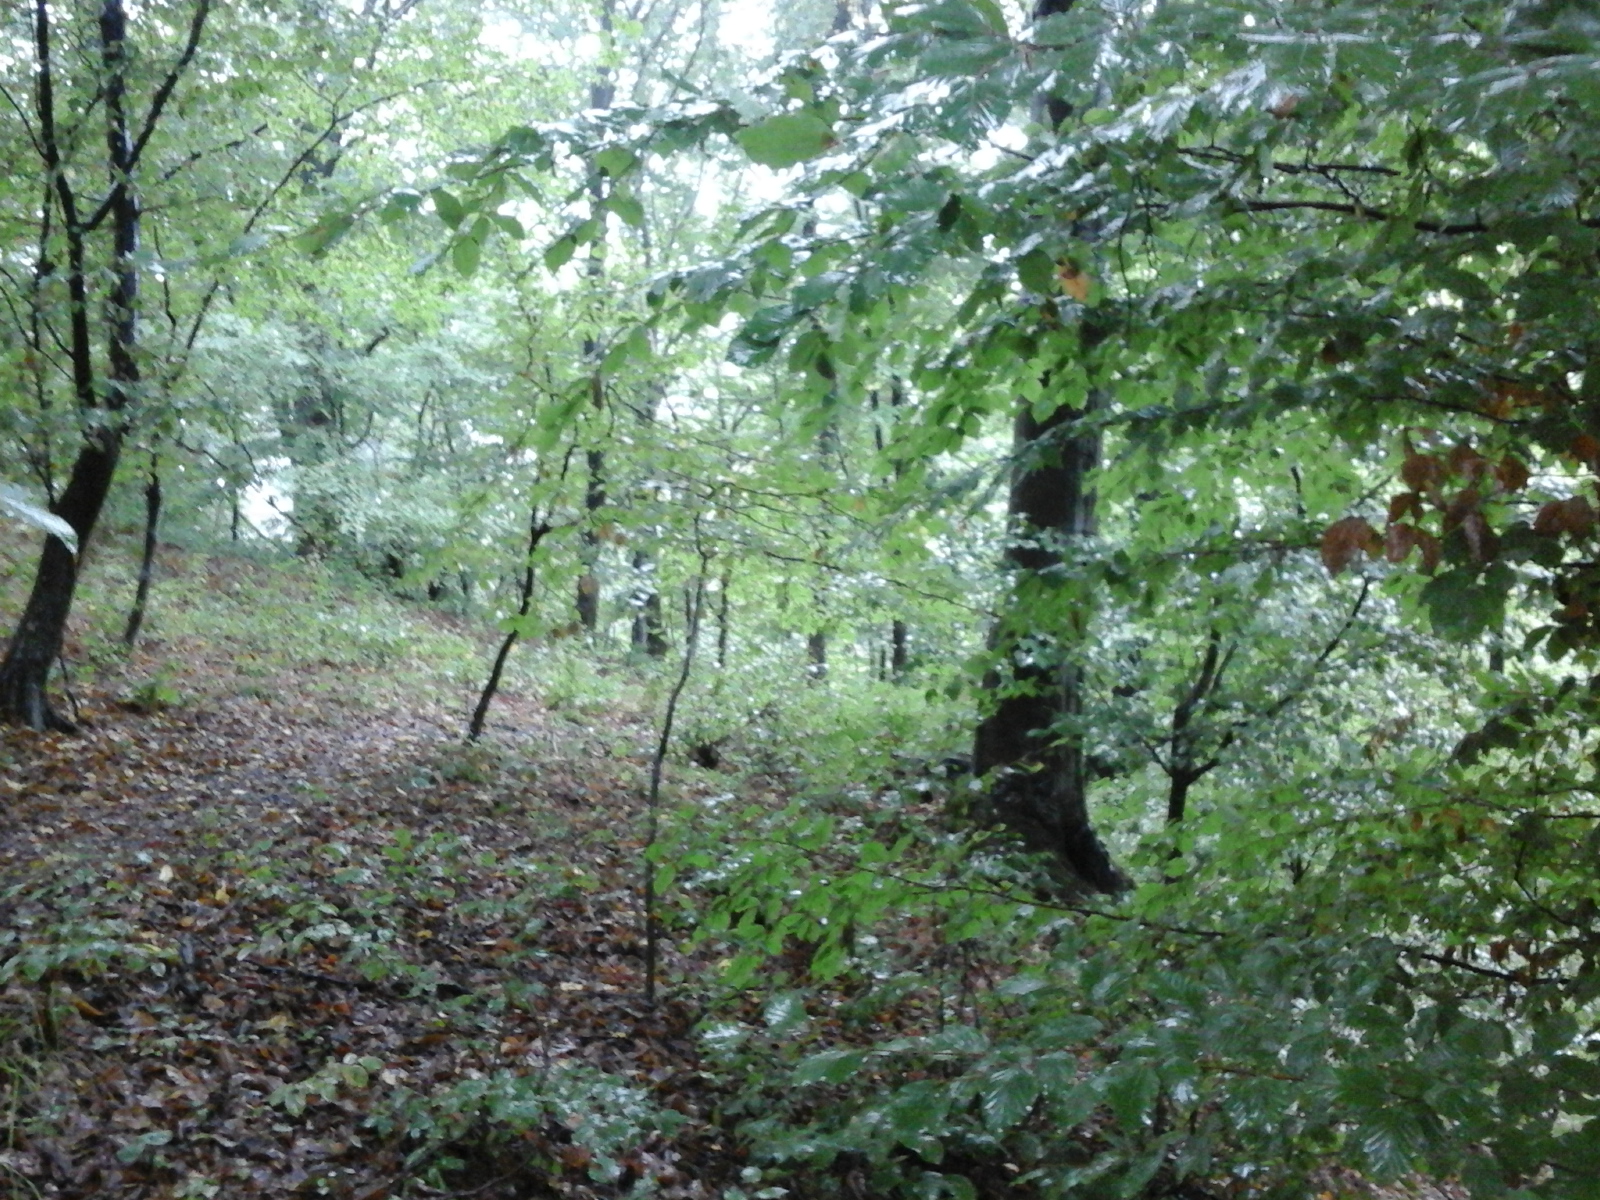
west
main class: Woodland
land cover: Broadleaved woodland
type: acidophilous oak and oak-birch forest
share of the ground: > 75 %
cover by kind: broadleaved forest trees 100 %
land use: Forestry
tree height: > 5 m
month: September
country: RO
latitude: 45.0645
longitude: 23.6882
